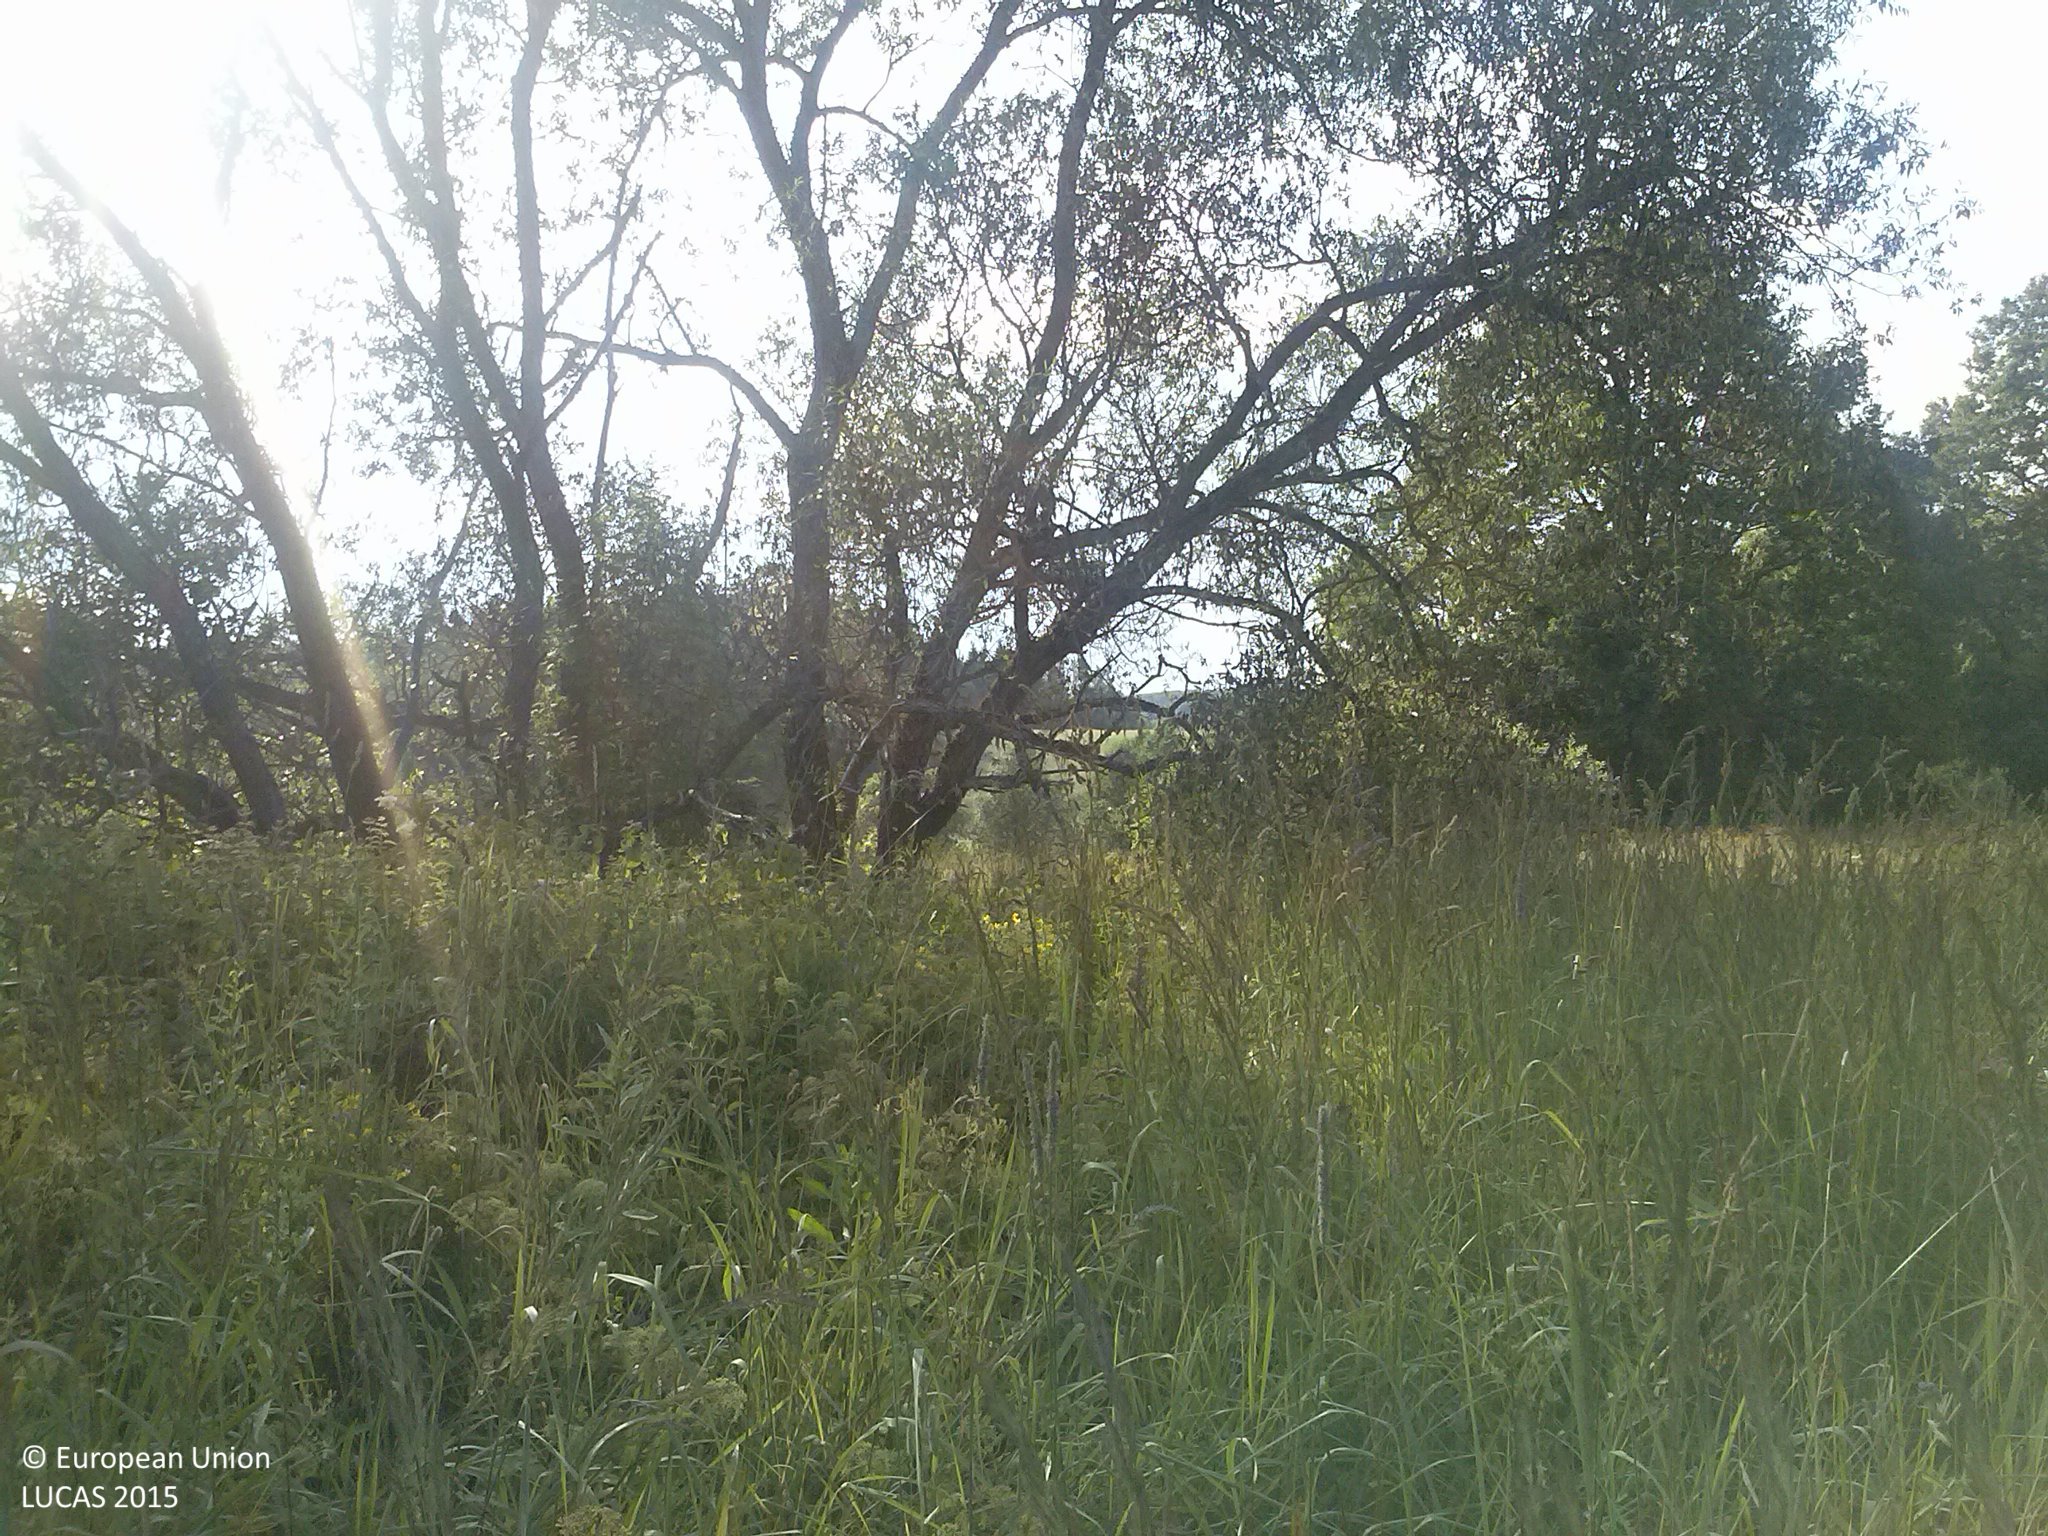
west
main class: Grassland
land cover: Spontaneously vegetated surfaces
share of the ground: > 75 %
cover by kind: herbaceous plants 100 %
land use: Semi-natural and natural areas not in use
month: July
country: LV
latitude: 56.6655
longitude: 27.3887
